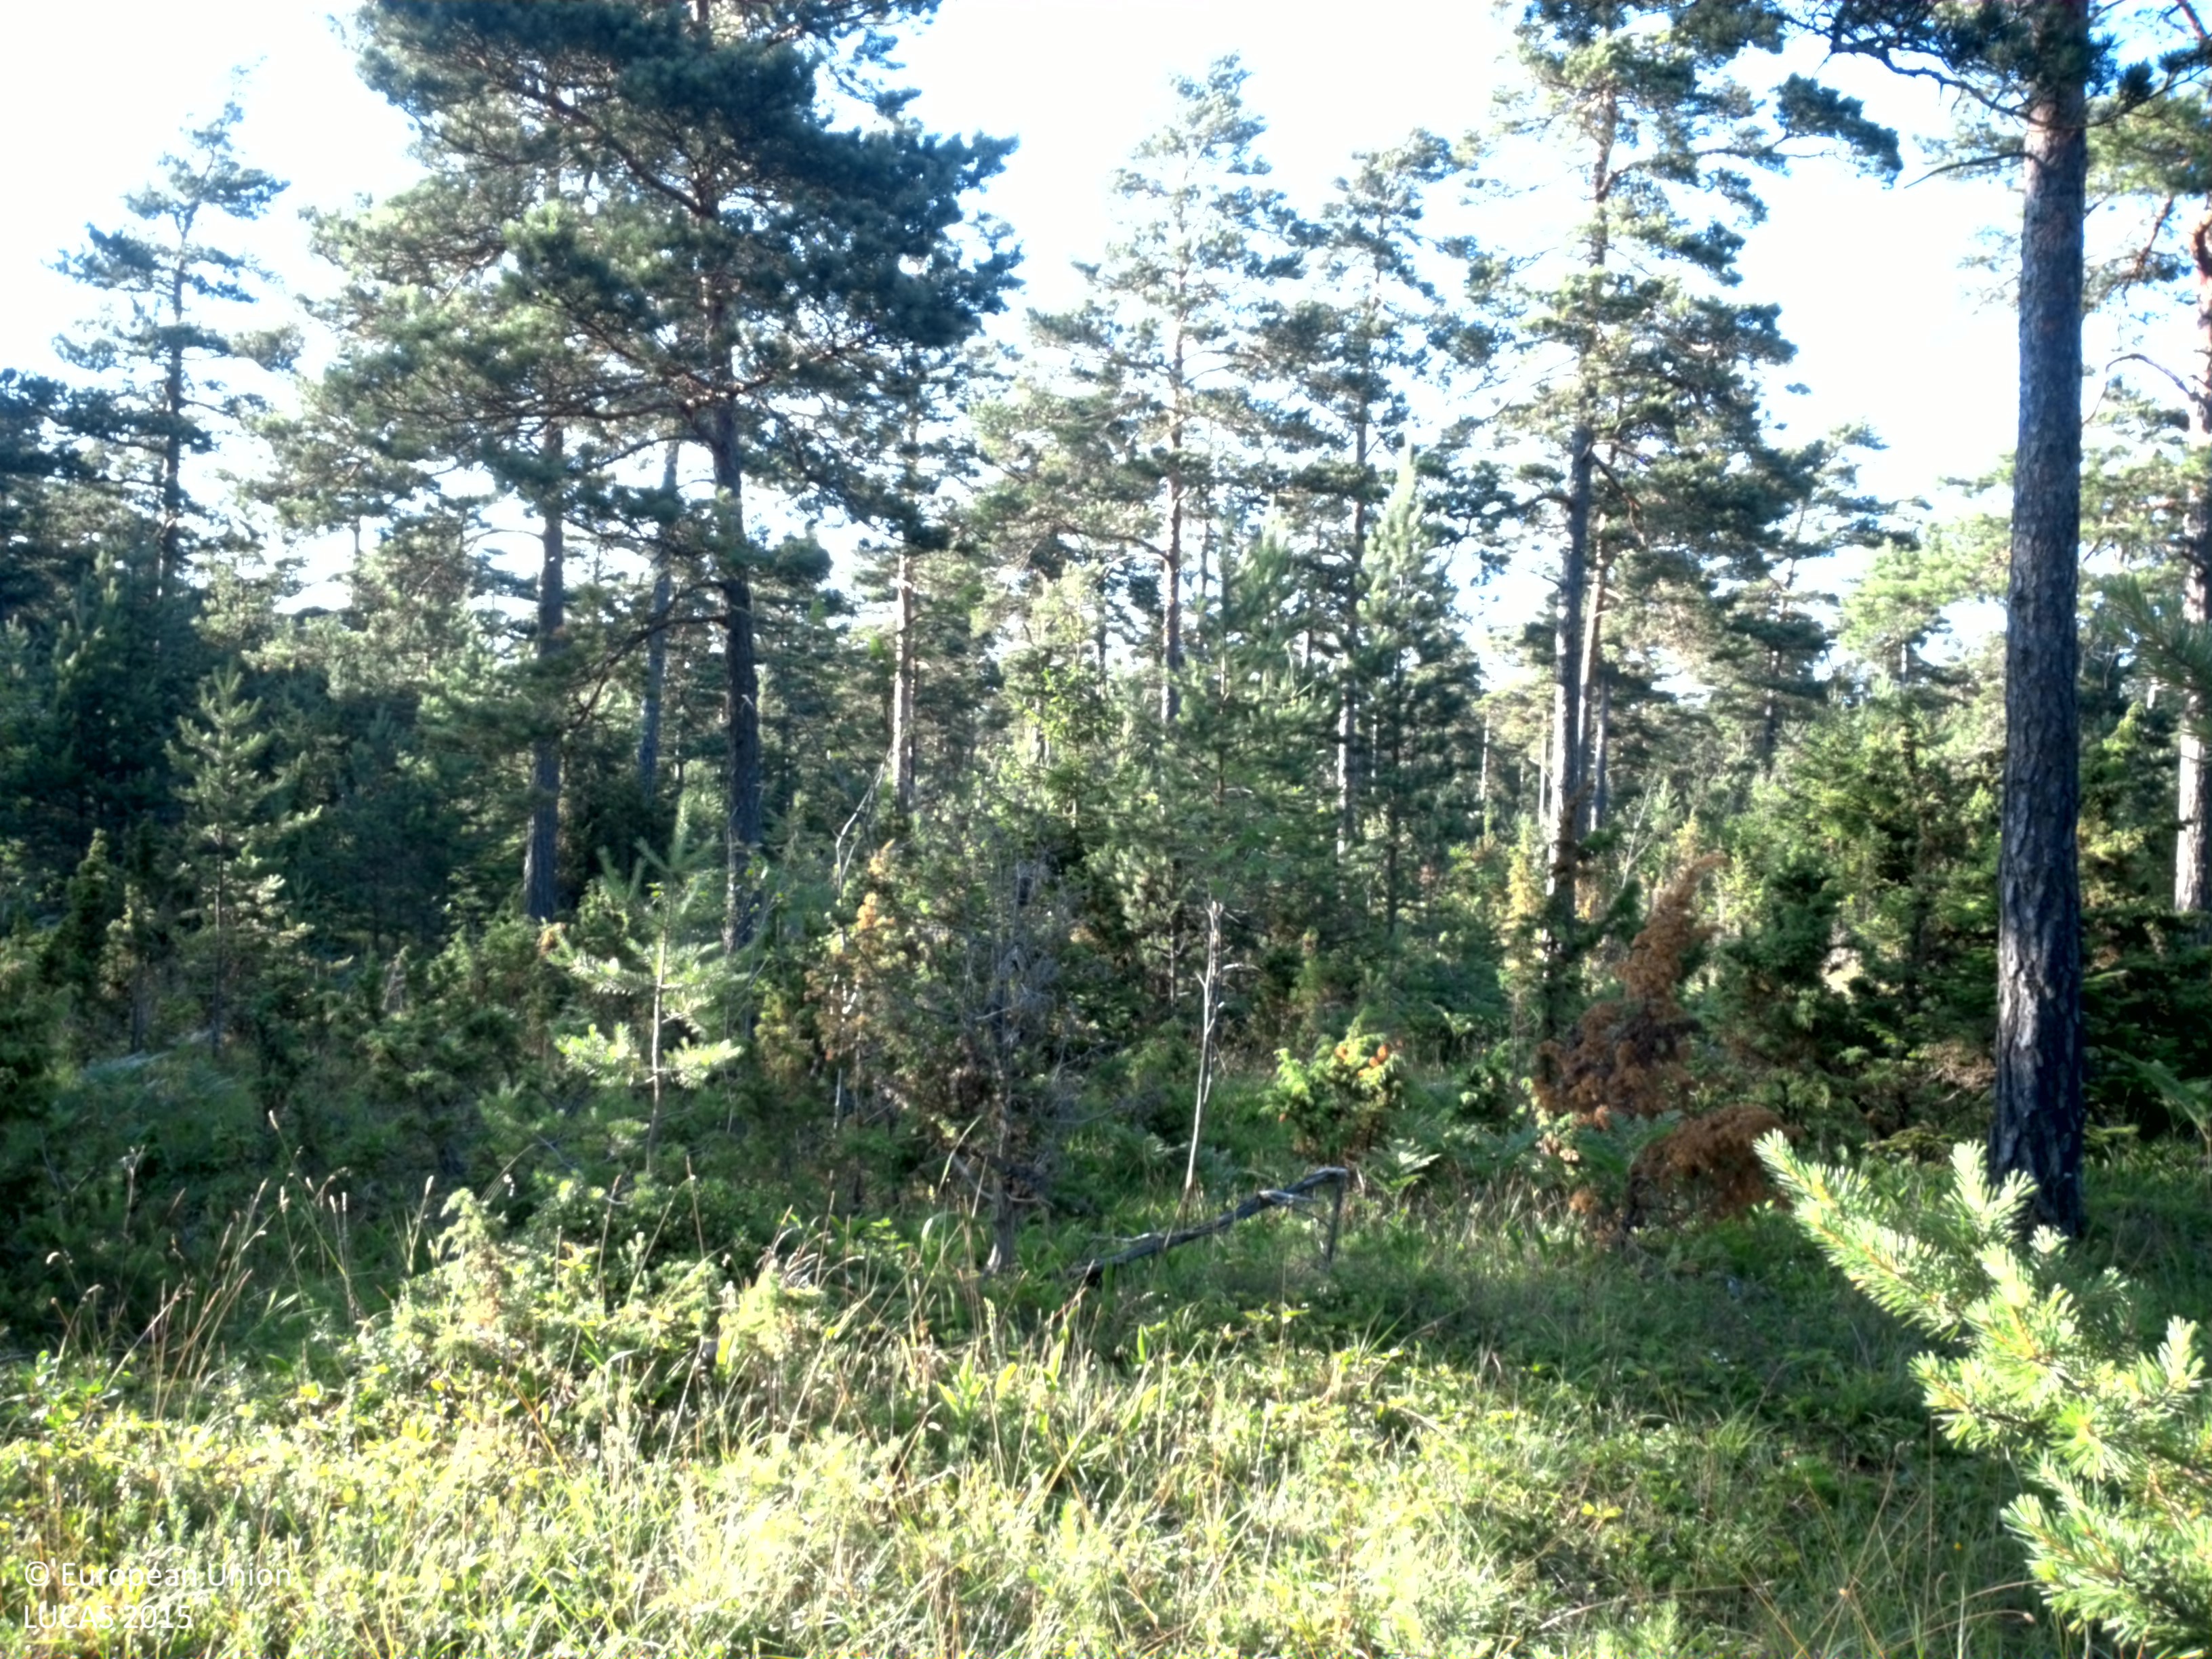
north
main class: Woodland
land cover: Pine dominated coniferous woodland
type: hemiboreal forest and nemoral coniferous forest and mixed broadleaved-coniferous forest
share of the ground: 50 - 75 %
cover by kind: coniferous forest trees 65 %, herbaceous plants 20 %, shrubs 15 %
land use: Forestry
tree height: > 5 m
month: July
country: SE
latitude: 57.6049
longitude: 18.7963
